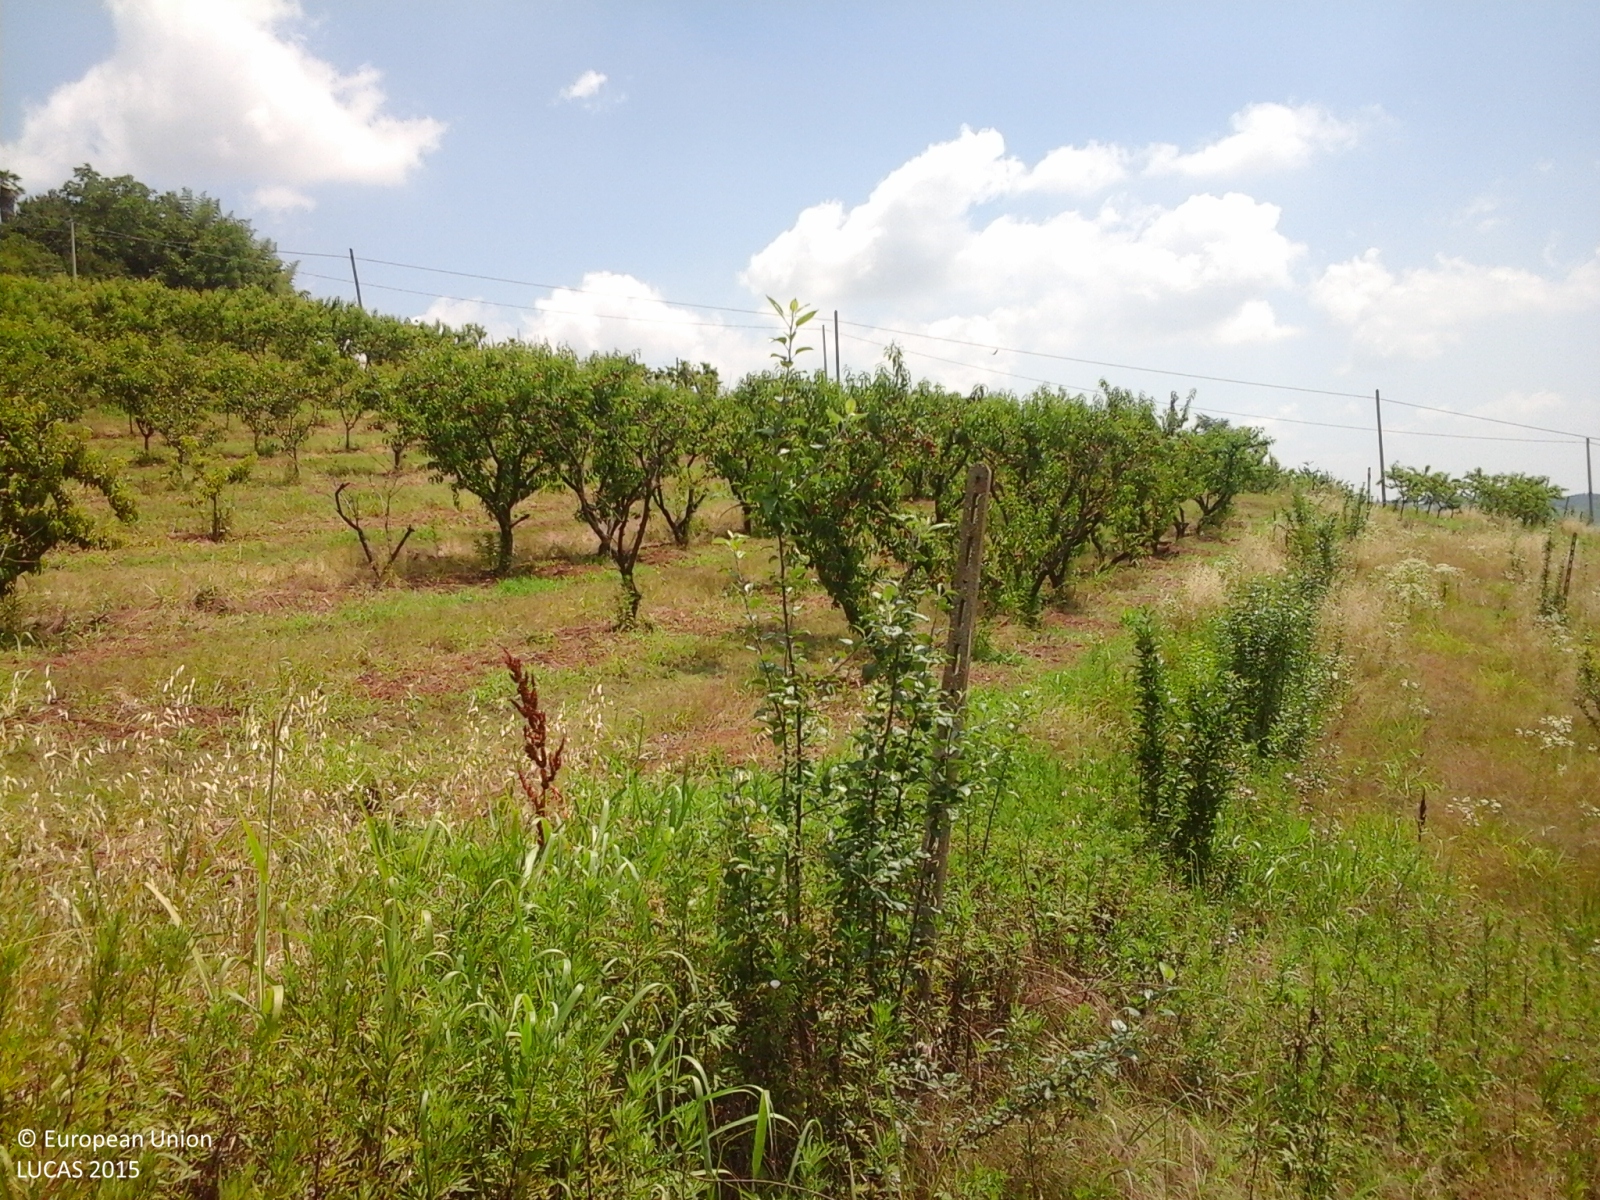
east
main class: Cropland
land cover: Other fruit trees and berries
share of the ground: > 75 %
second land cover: Grassland without tree/shrub cover
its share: > 75 %
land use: Agriculture (excluding fallow land and kitchen gardens)
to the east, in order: Other fruit trees and berries; Grassland without tree/shrub cover; Tracks; Grassland with sparse tree/shrub cover; Electric lines; Other fruit trees and berries; Grass margins; Paved roads, cycling and walking lanes; Grass margins; Broadleaved woodland; Grass margins; Artificial constructions in urban areas
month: June
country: IT
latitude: 45.0566
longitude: 8.2128
